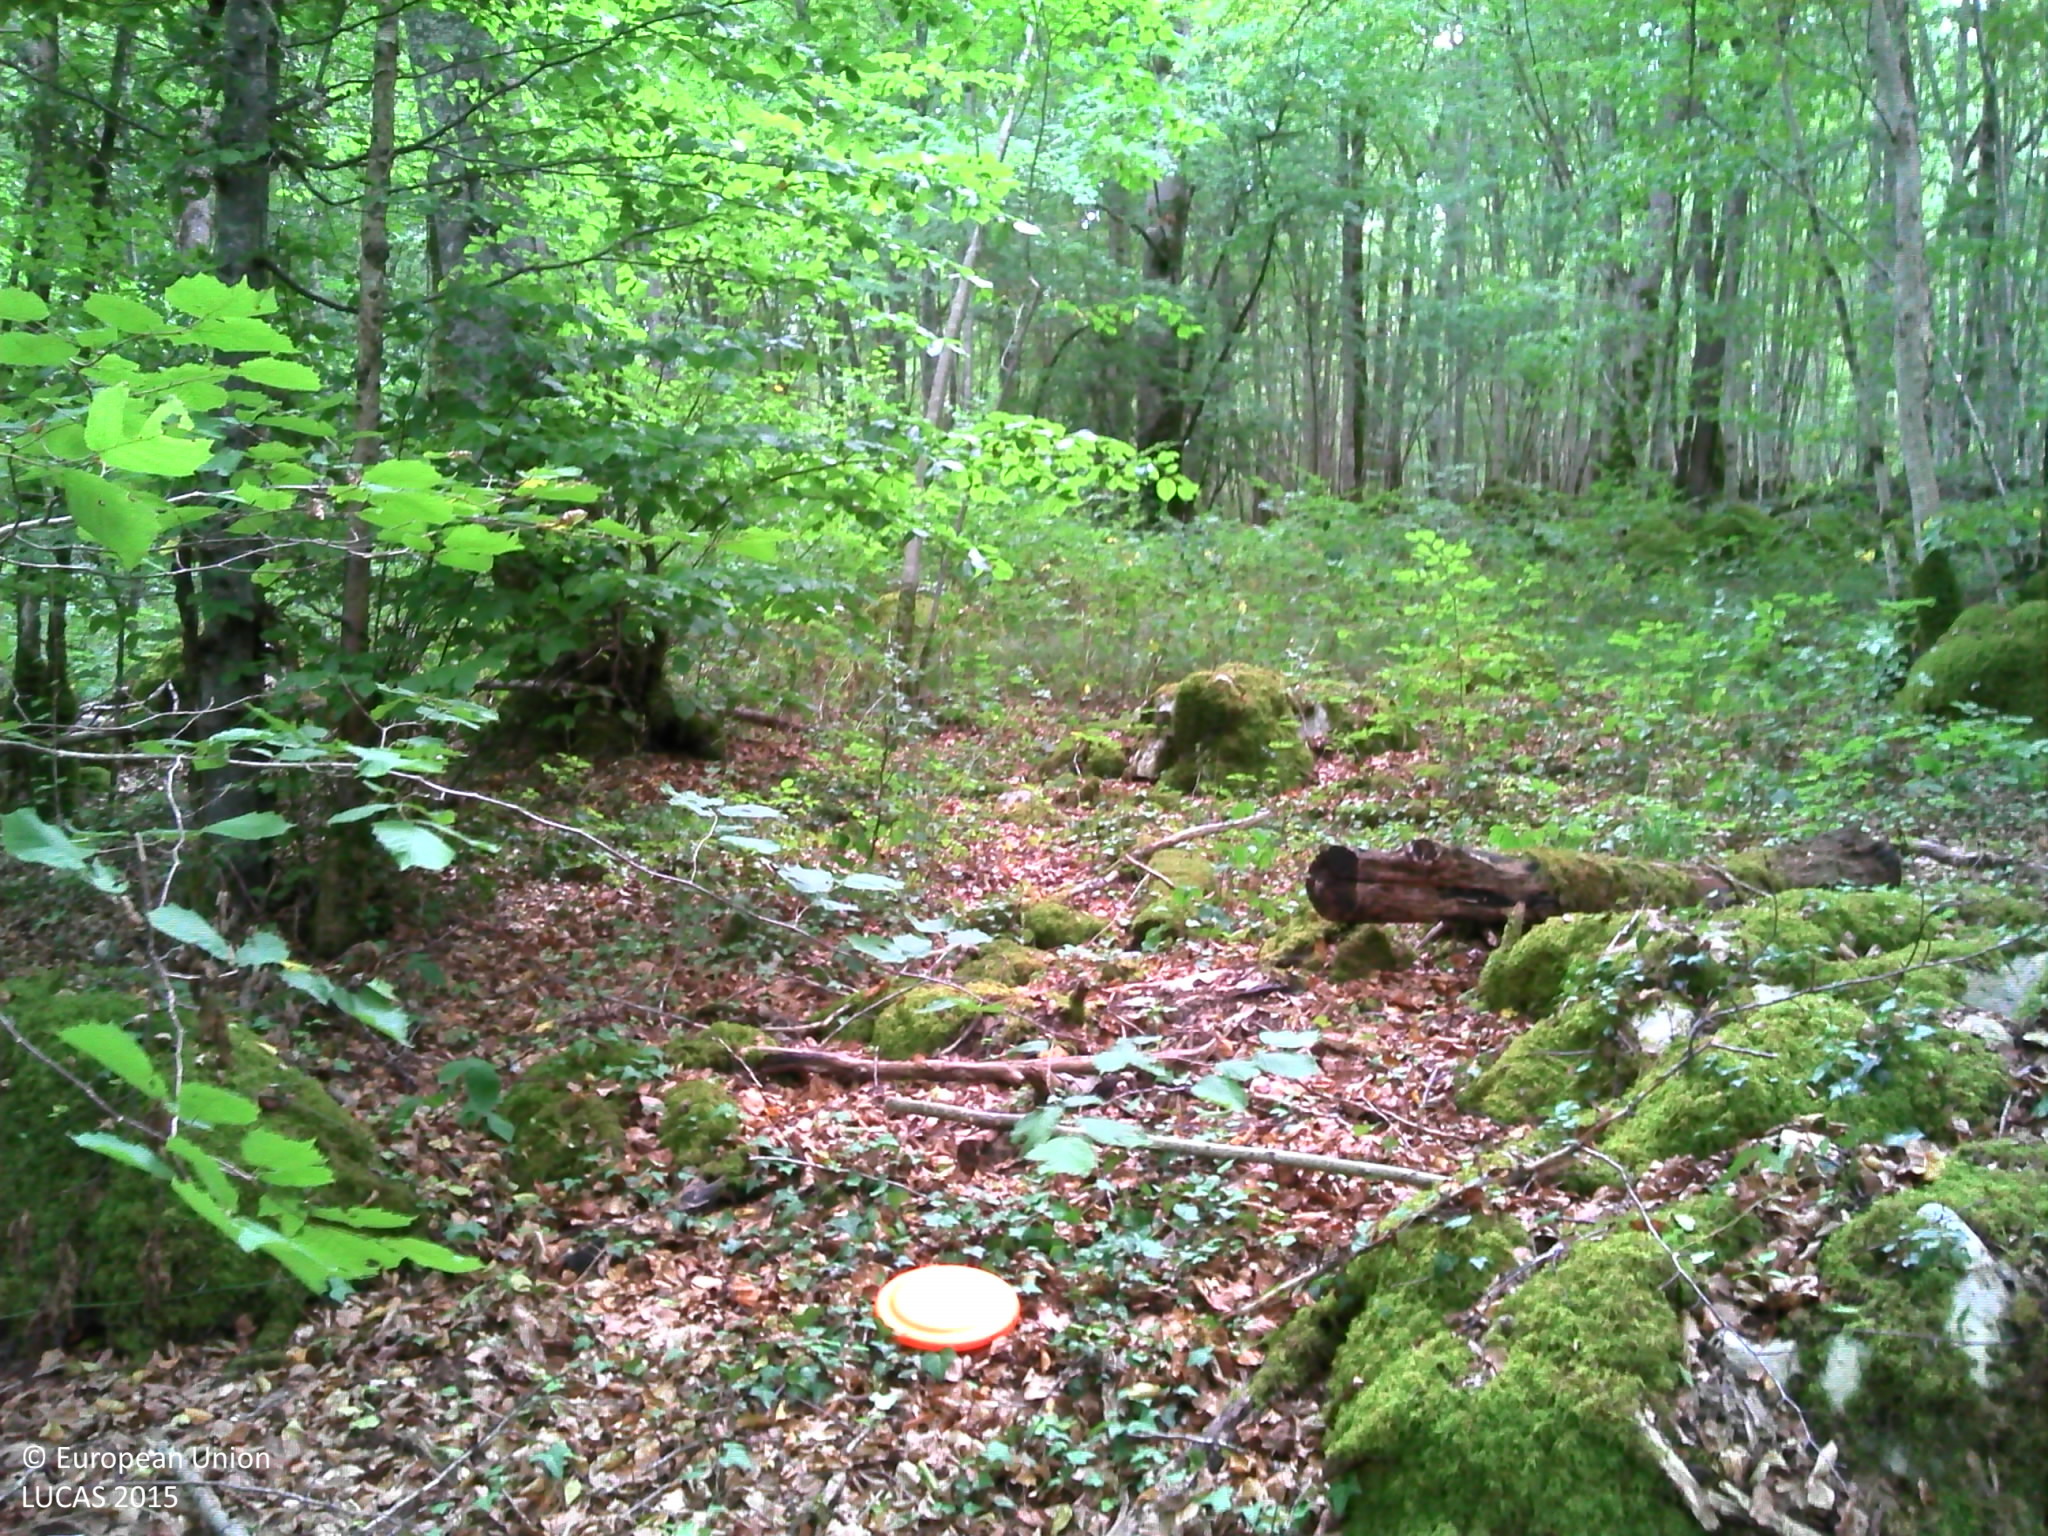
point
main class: Woodland
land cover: Broadleaved woodland
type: beech forest
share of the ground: > 75 %
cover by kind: broadleaved forest trees 90 %, herbaceous plants 5 %, lichens and mosses 5 %
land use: Forestry
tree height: > 5 m
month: August
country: FR
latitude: 47.7625
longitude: 4.8895
